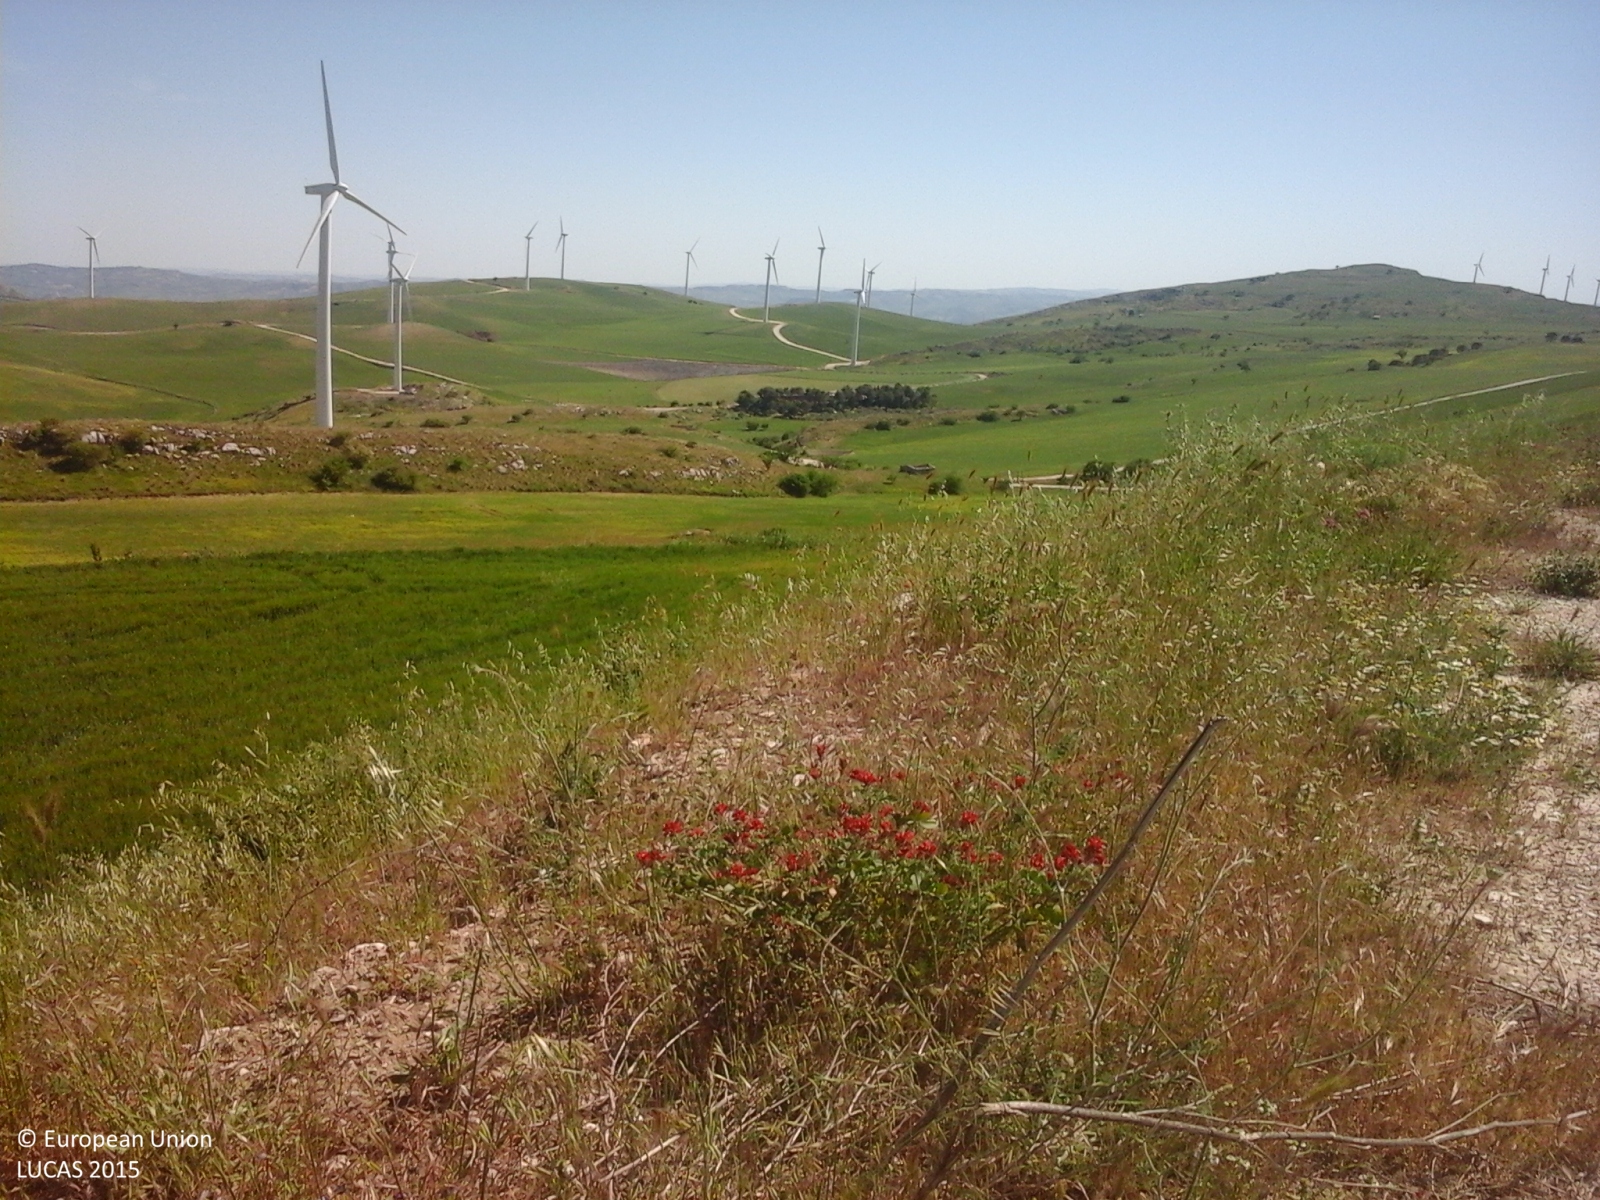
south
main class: Cropland
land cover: Durum wheat
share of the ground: > 75 %
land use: Agriculture (excluding fallow land and kitchen gardens)
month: May
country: IT
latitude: 37.6273
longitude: 13.9931
